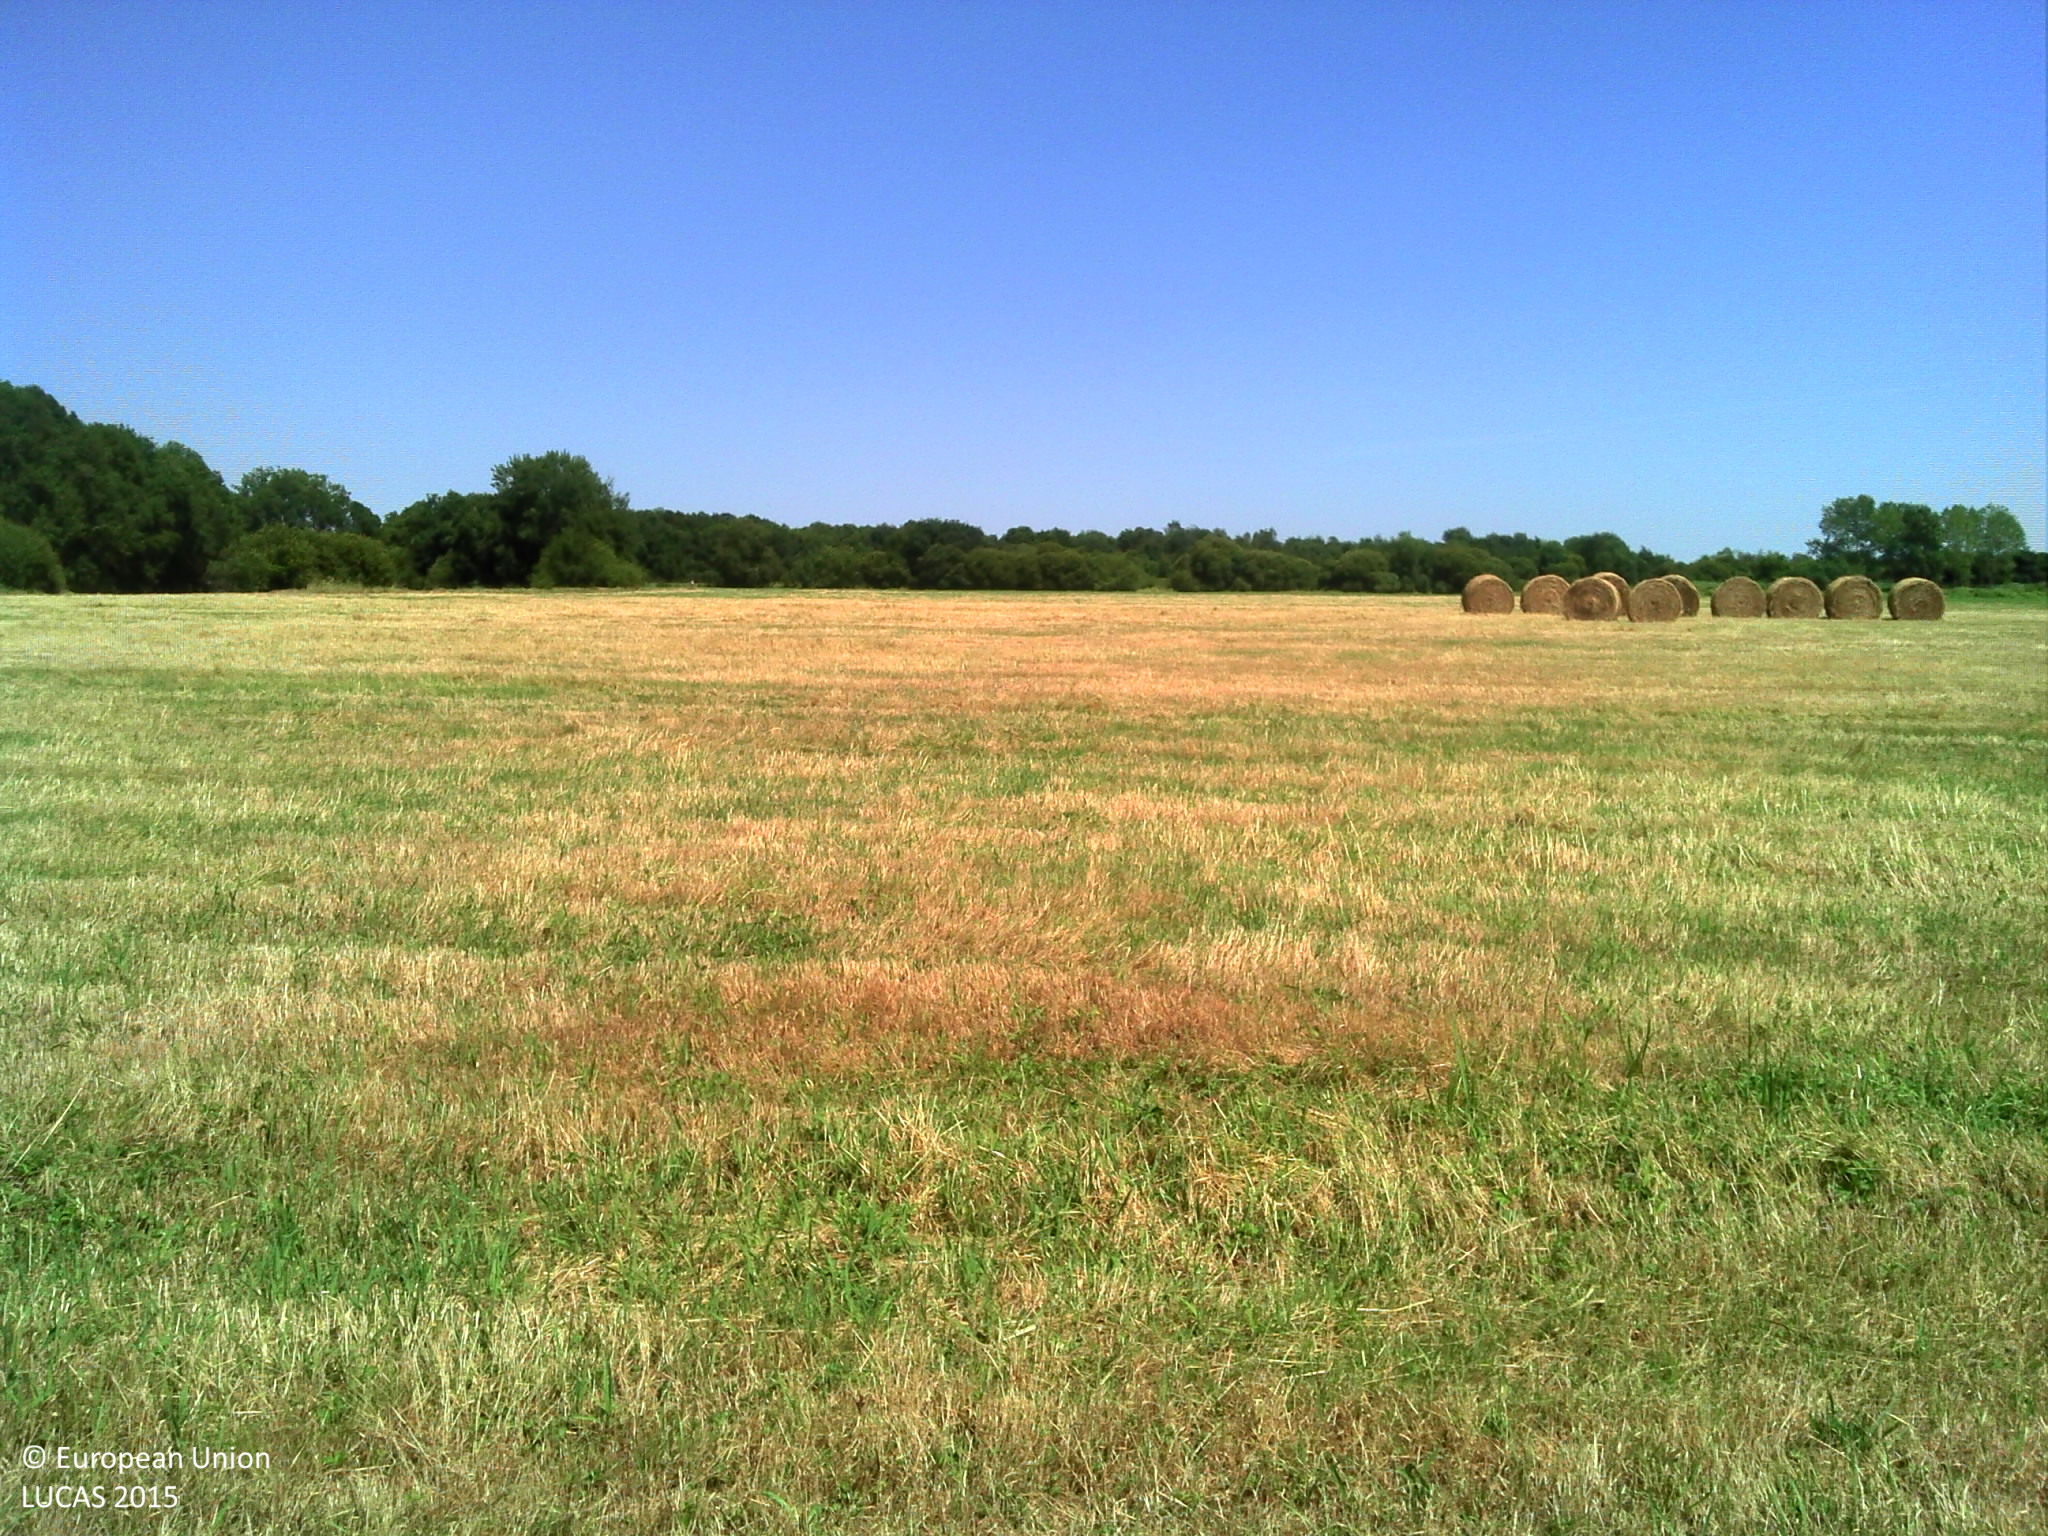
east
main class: Grassland
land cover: Grassland without tree/shrub cover
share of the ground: > 75 %
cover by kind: herbaceous plants 100 %
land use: Agriculture (excluding fallow land and kitchen gardens)
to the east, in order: Grassland without tree/shrub cover
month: July
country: FR
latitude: 47.6718
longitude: -2.0242
